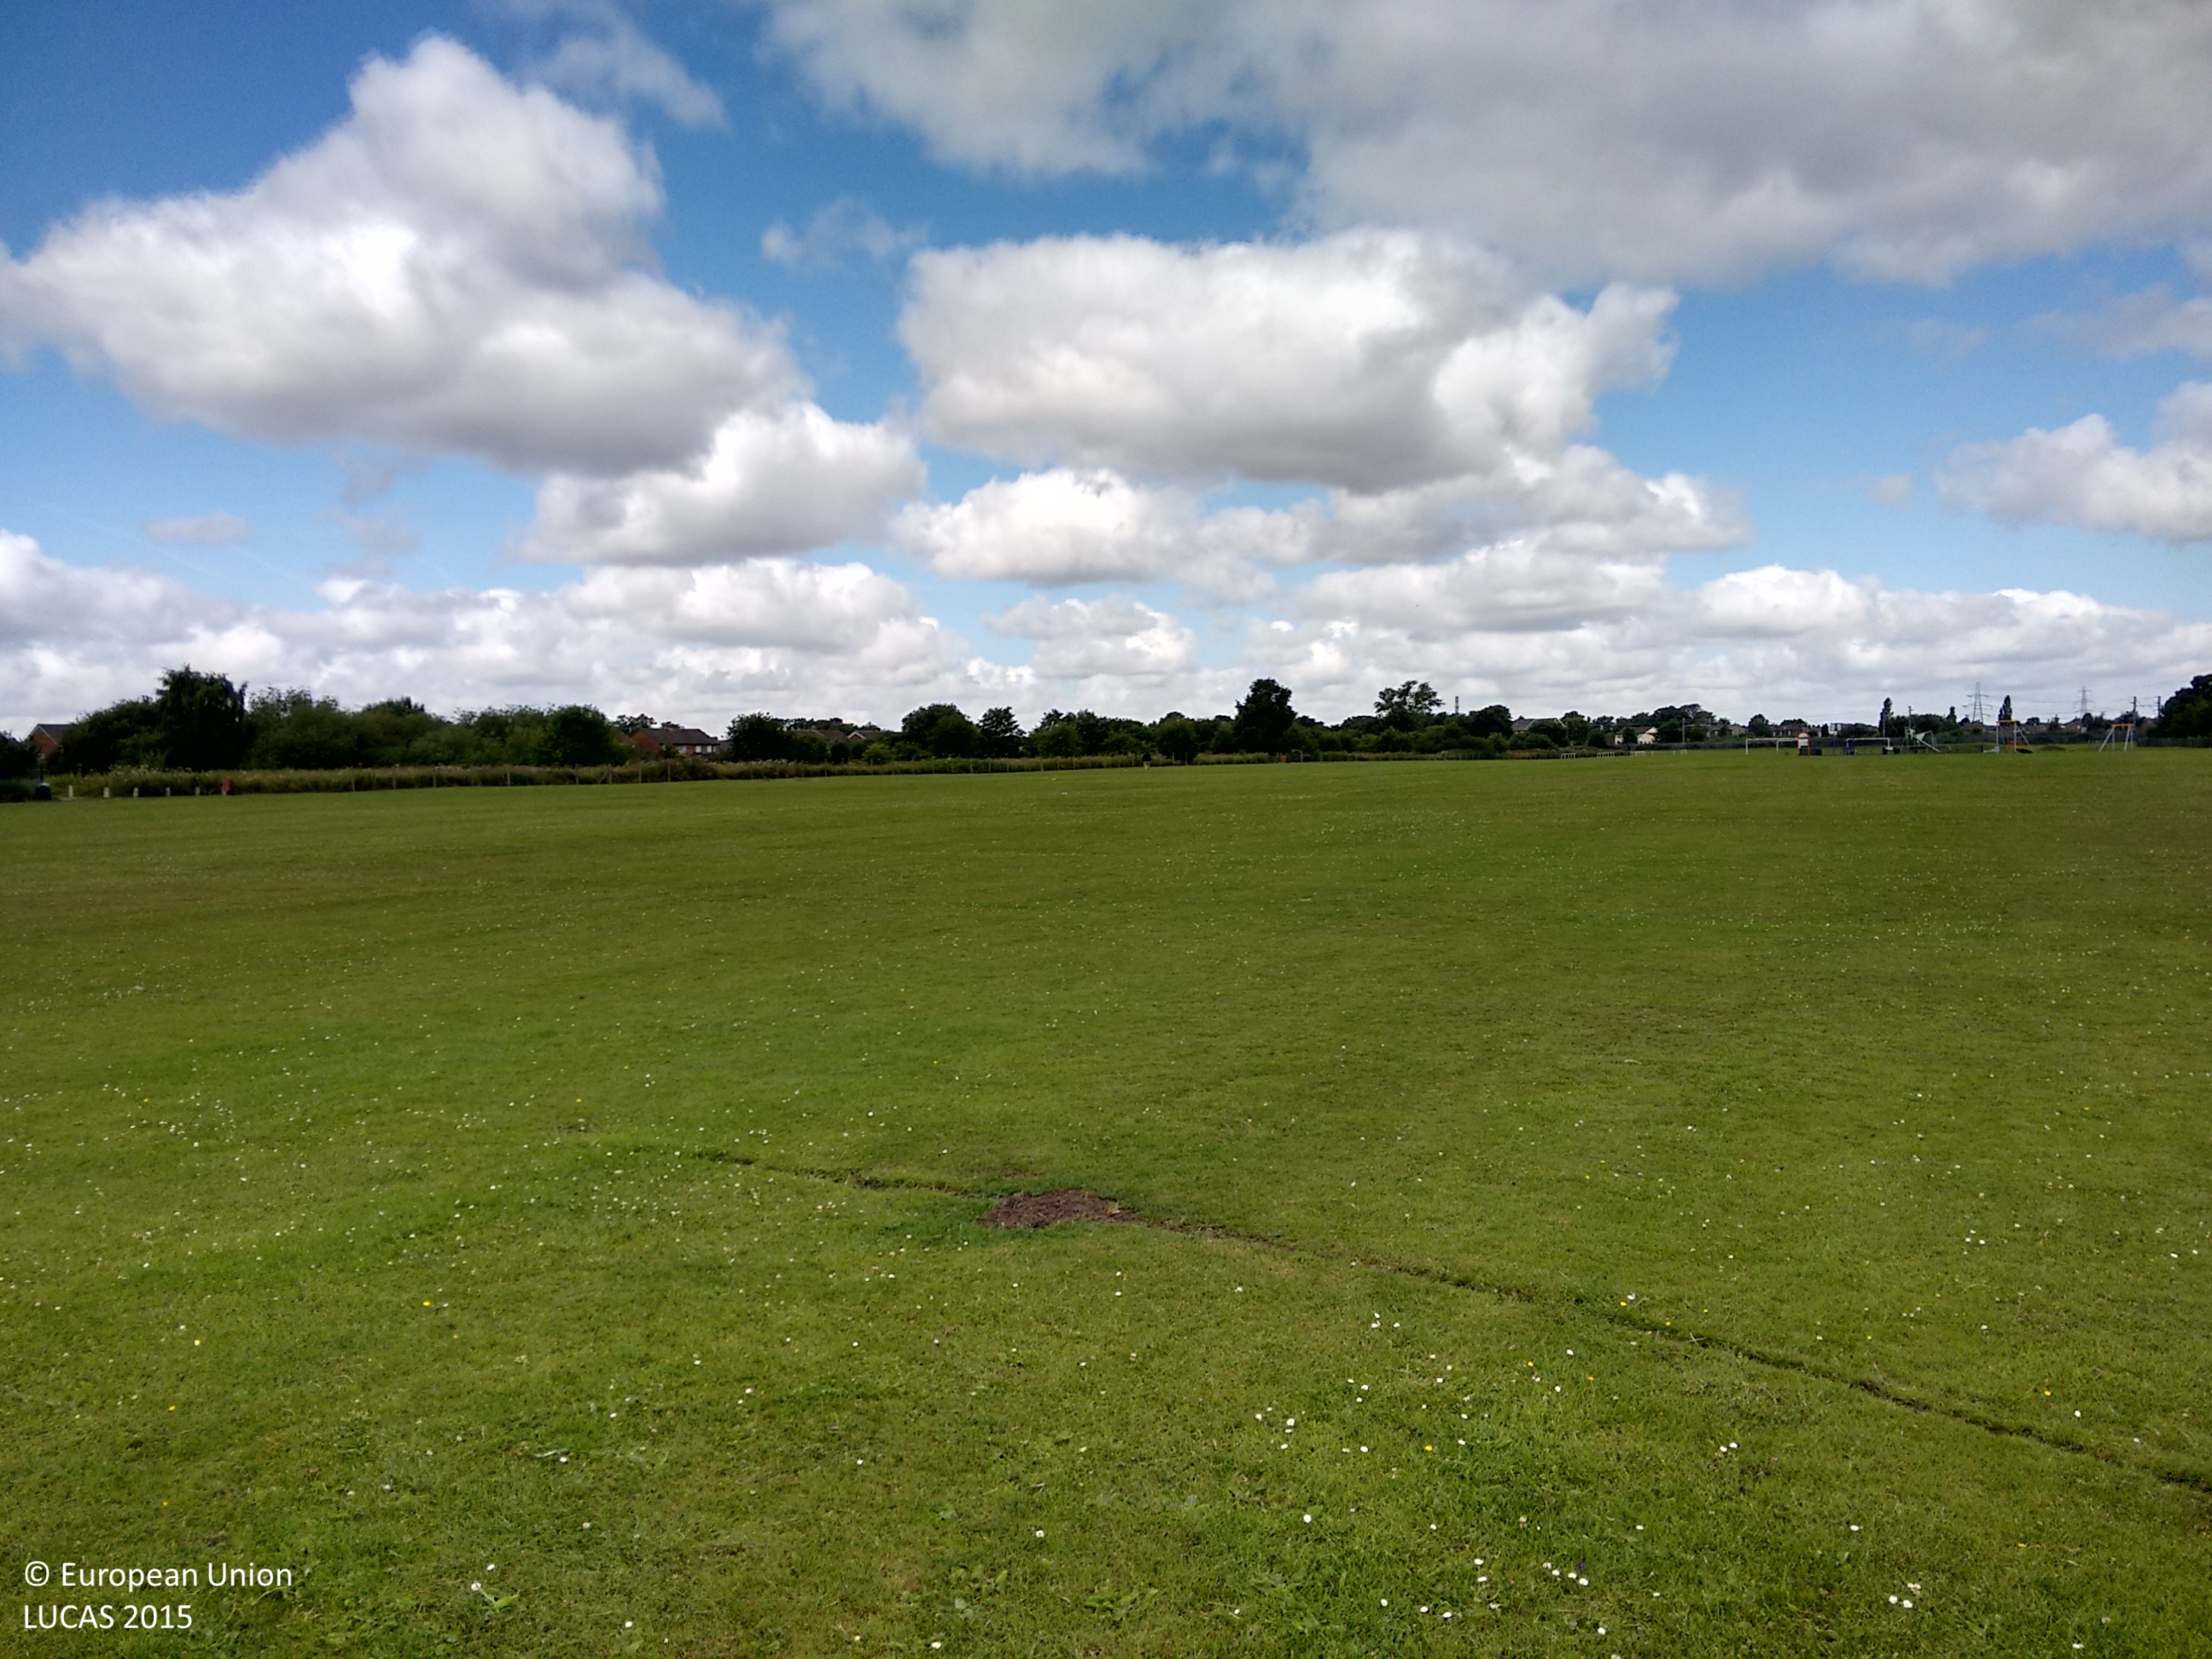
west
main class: Grassland
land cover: Grassland without tree/shrub cover
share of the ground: > 75 %
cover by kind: herbaceous plants 100 %
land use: Sport
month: July
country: GB
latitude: 53.4162
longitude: -2.7535
